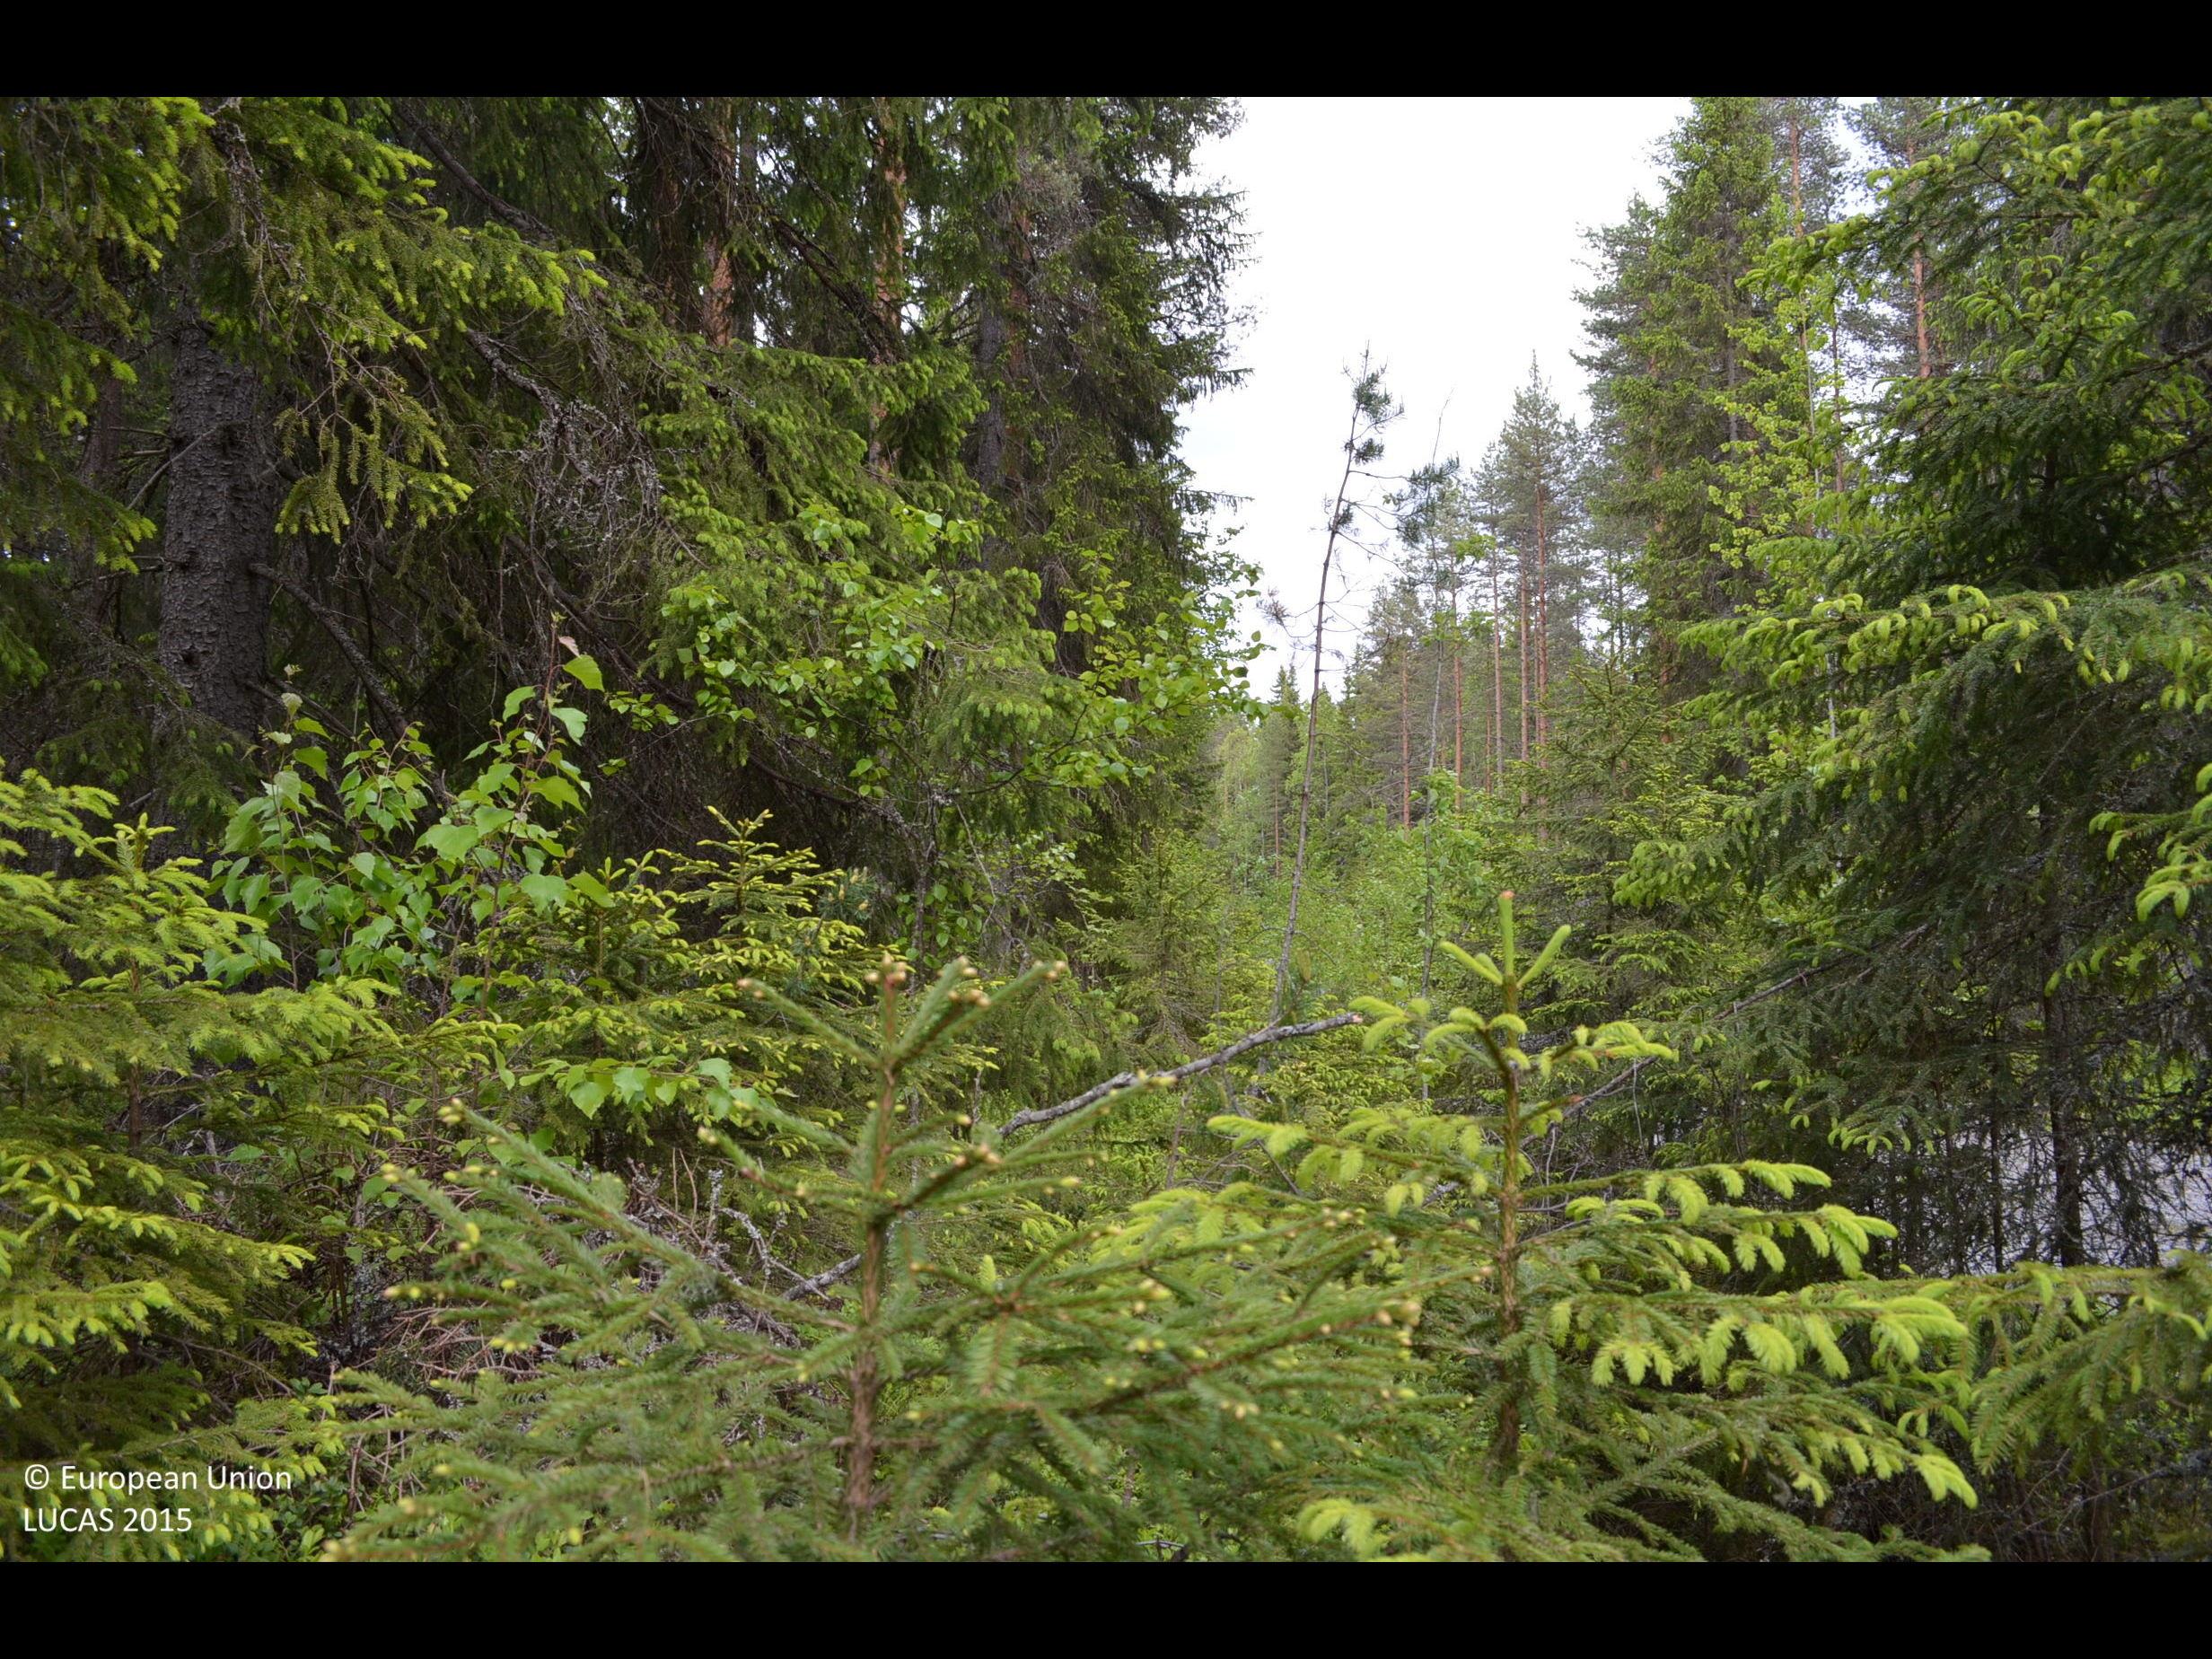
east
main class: Woodland
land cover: Other coniferous woodland
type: boreal forest
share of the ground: > 75 %
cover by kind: coniferous forest trees 65 %, shrubs 20 %, broadleaved forest trees 15 %
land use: Community services
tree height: > 5 m
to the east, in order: Other coniferous woodland; Ditches and canals; Other coniferous woodland; Tracks; Ditches and canals; Other coniferous woodland; Pine dominated coniferous woodland; Ponds and wetlands
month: June
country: FI
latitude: 61.9406
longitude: 23.3559
